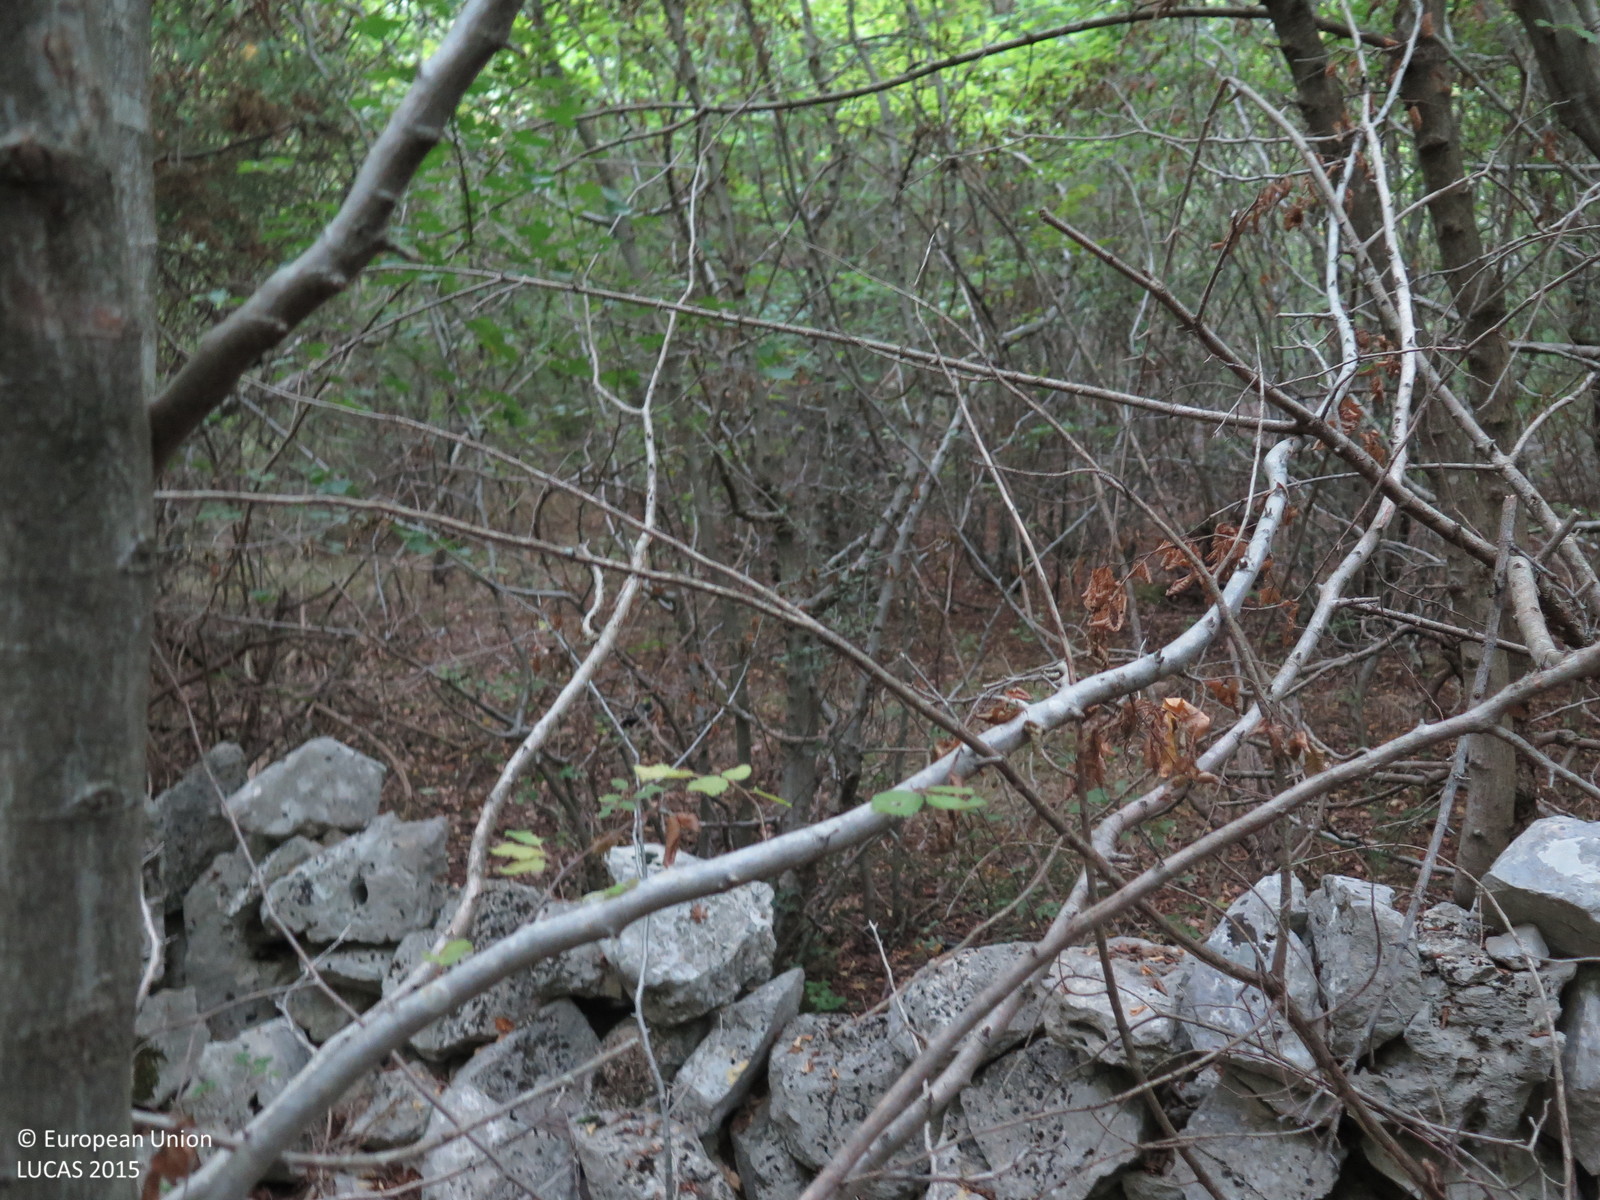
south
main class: Woodland
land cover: Broadleaved woodland
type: beech forest
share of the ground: > 75 %
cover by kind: broadleaved forest trees 100 %
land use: Forestry
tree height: > 5 m
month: August
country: HR
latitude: 45.0970
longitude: 14.6072
